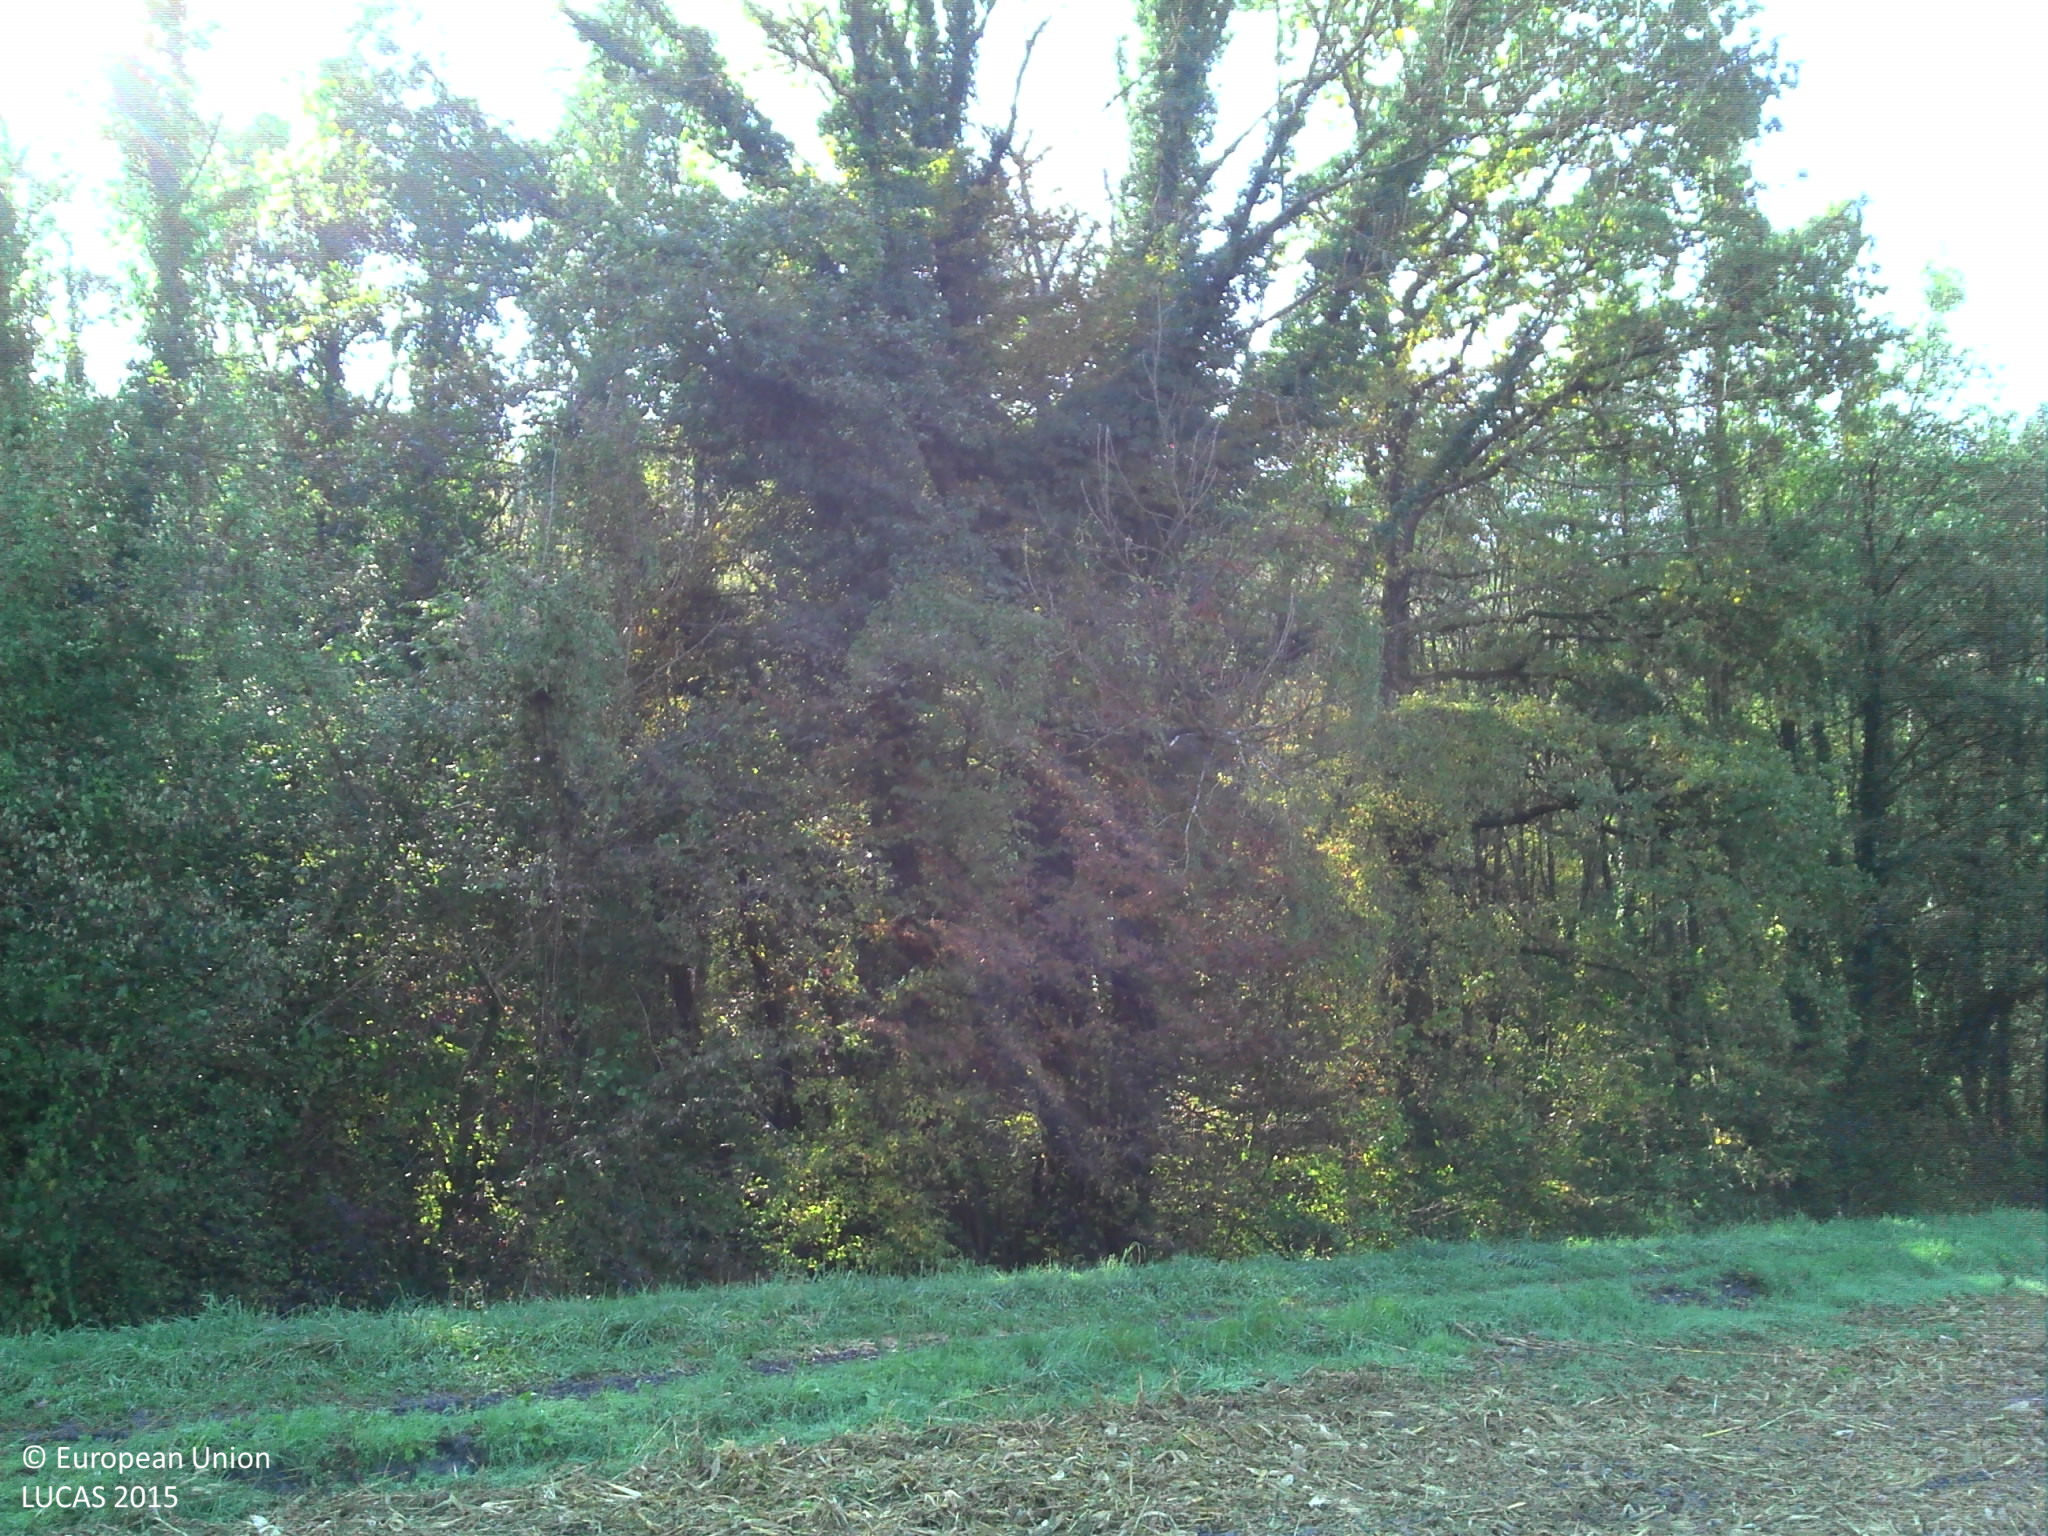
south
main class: Cropland
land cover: Maize
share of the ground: > 75 %
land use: Agriculture (excluding fallow land and kitchen gardens)
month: October
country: FR
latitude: 45.5425
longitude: 6.1496
